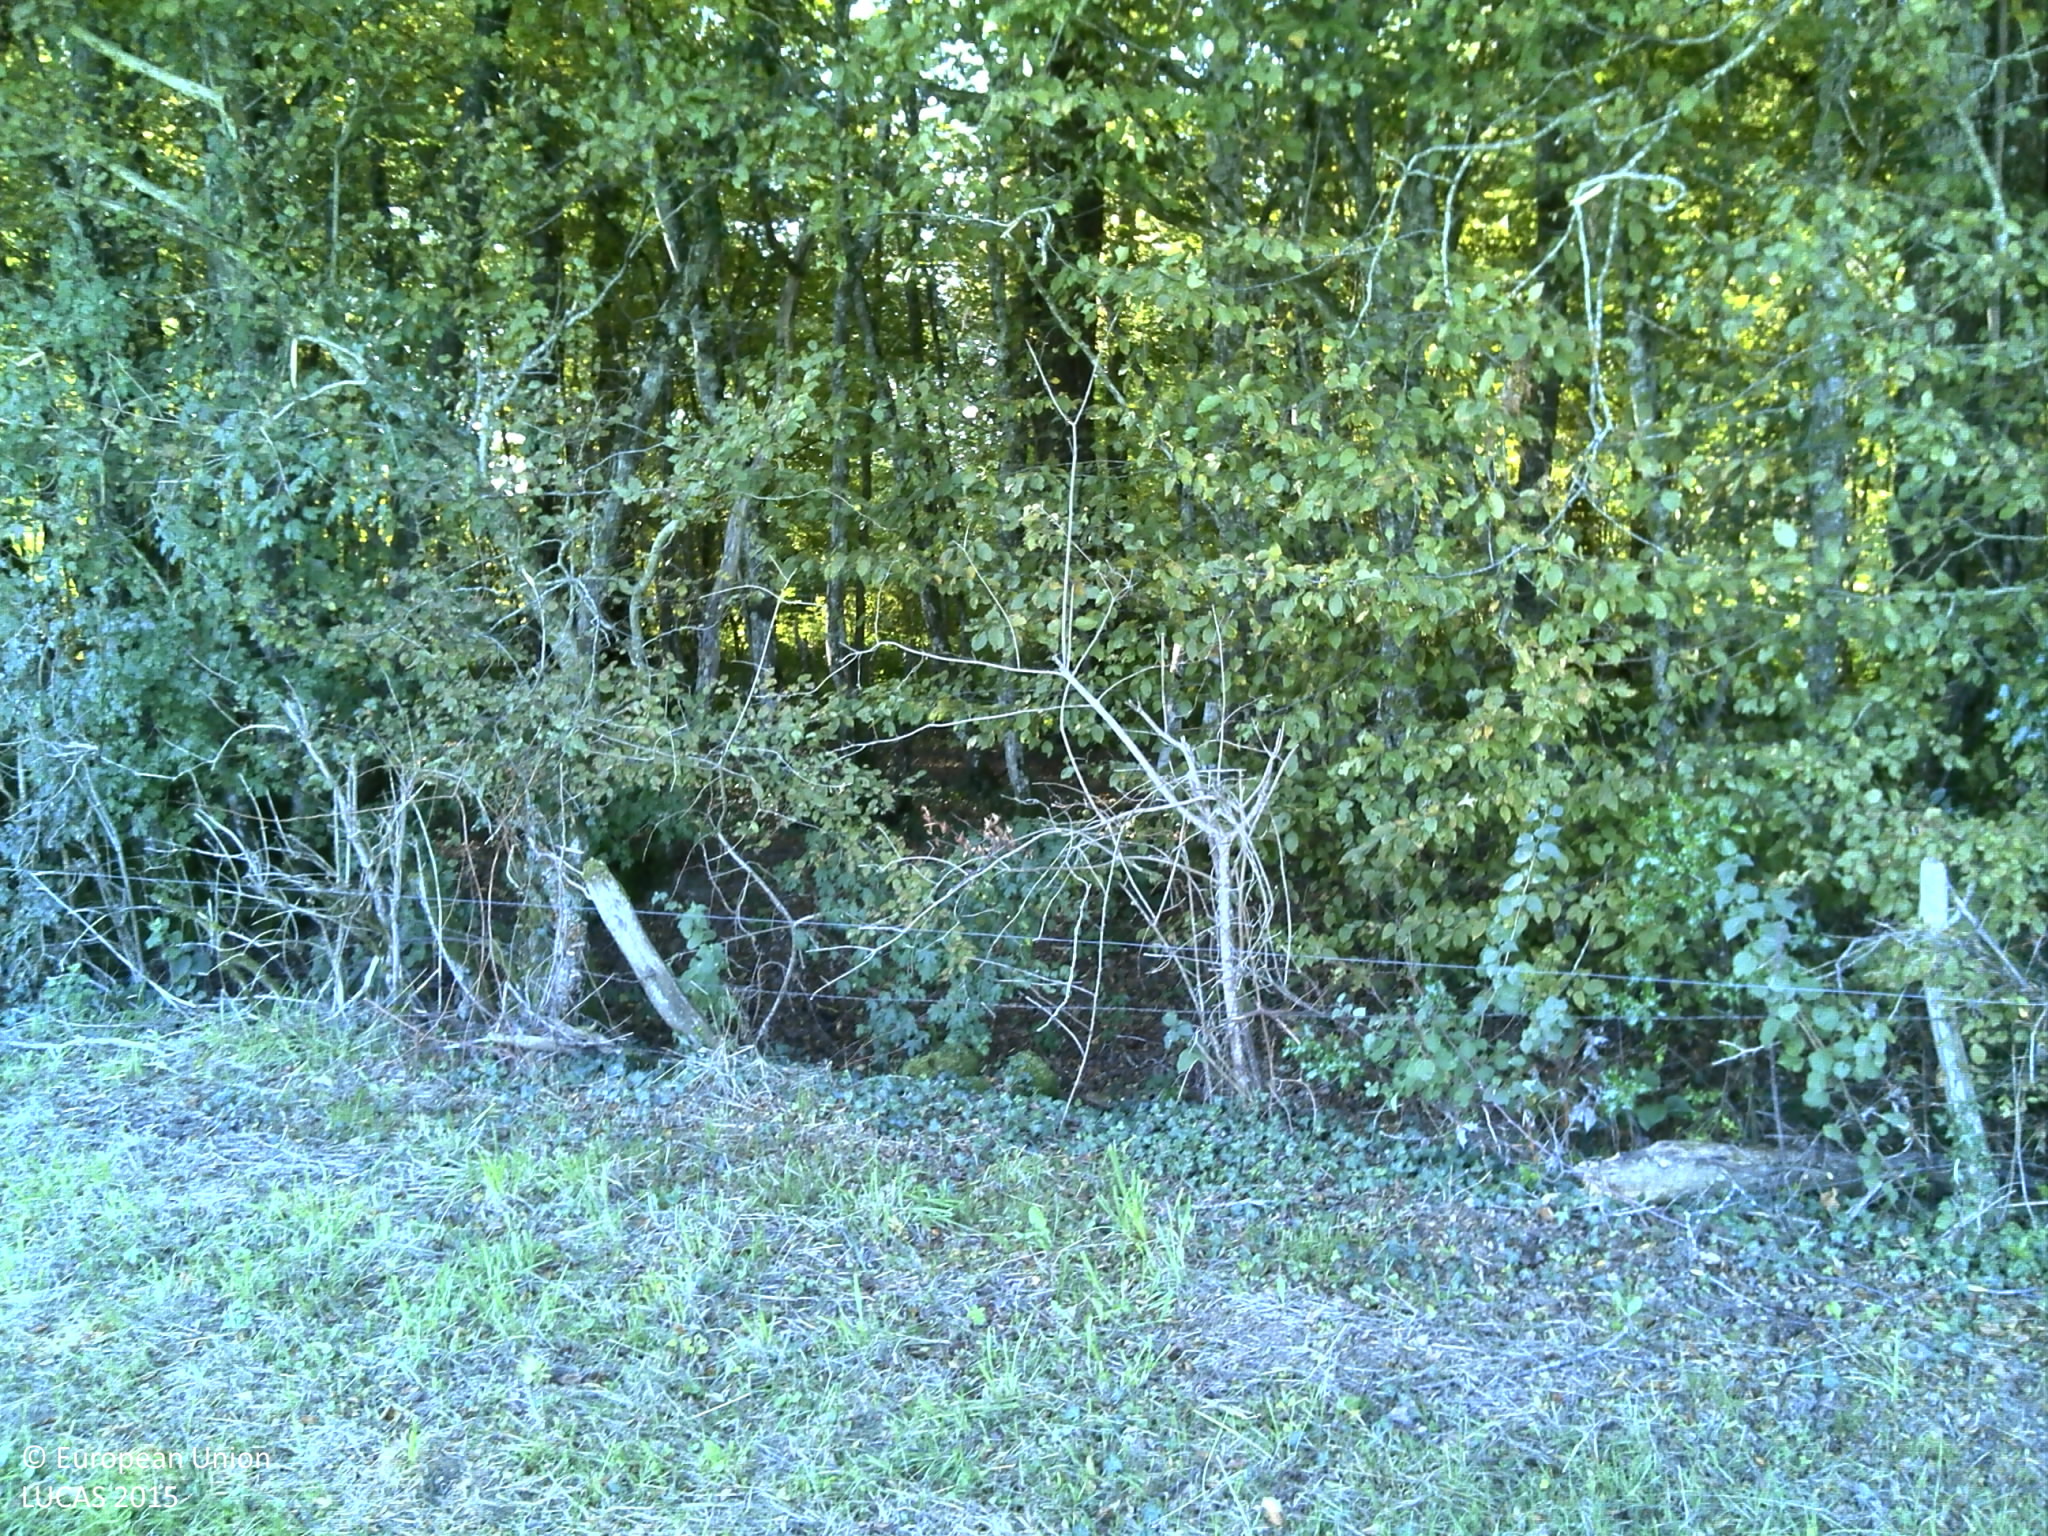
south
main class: Grassland
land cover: Grassland without tree/shrub cover
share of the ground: > 75 %
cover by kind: herbaceous plants 100 %
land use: Agriculture (excluding fallow land and kitchen gardens)
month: September
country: FR
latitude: 46.8902
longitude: 4.3961
